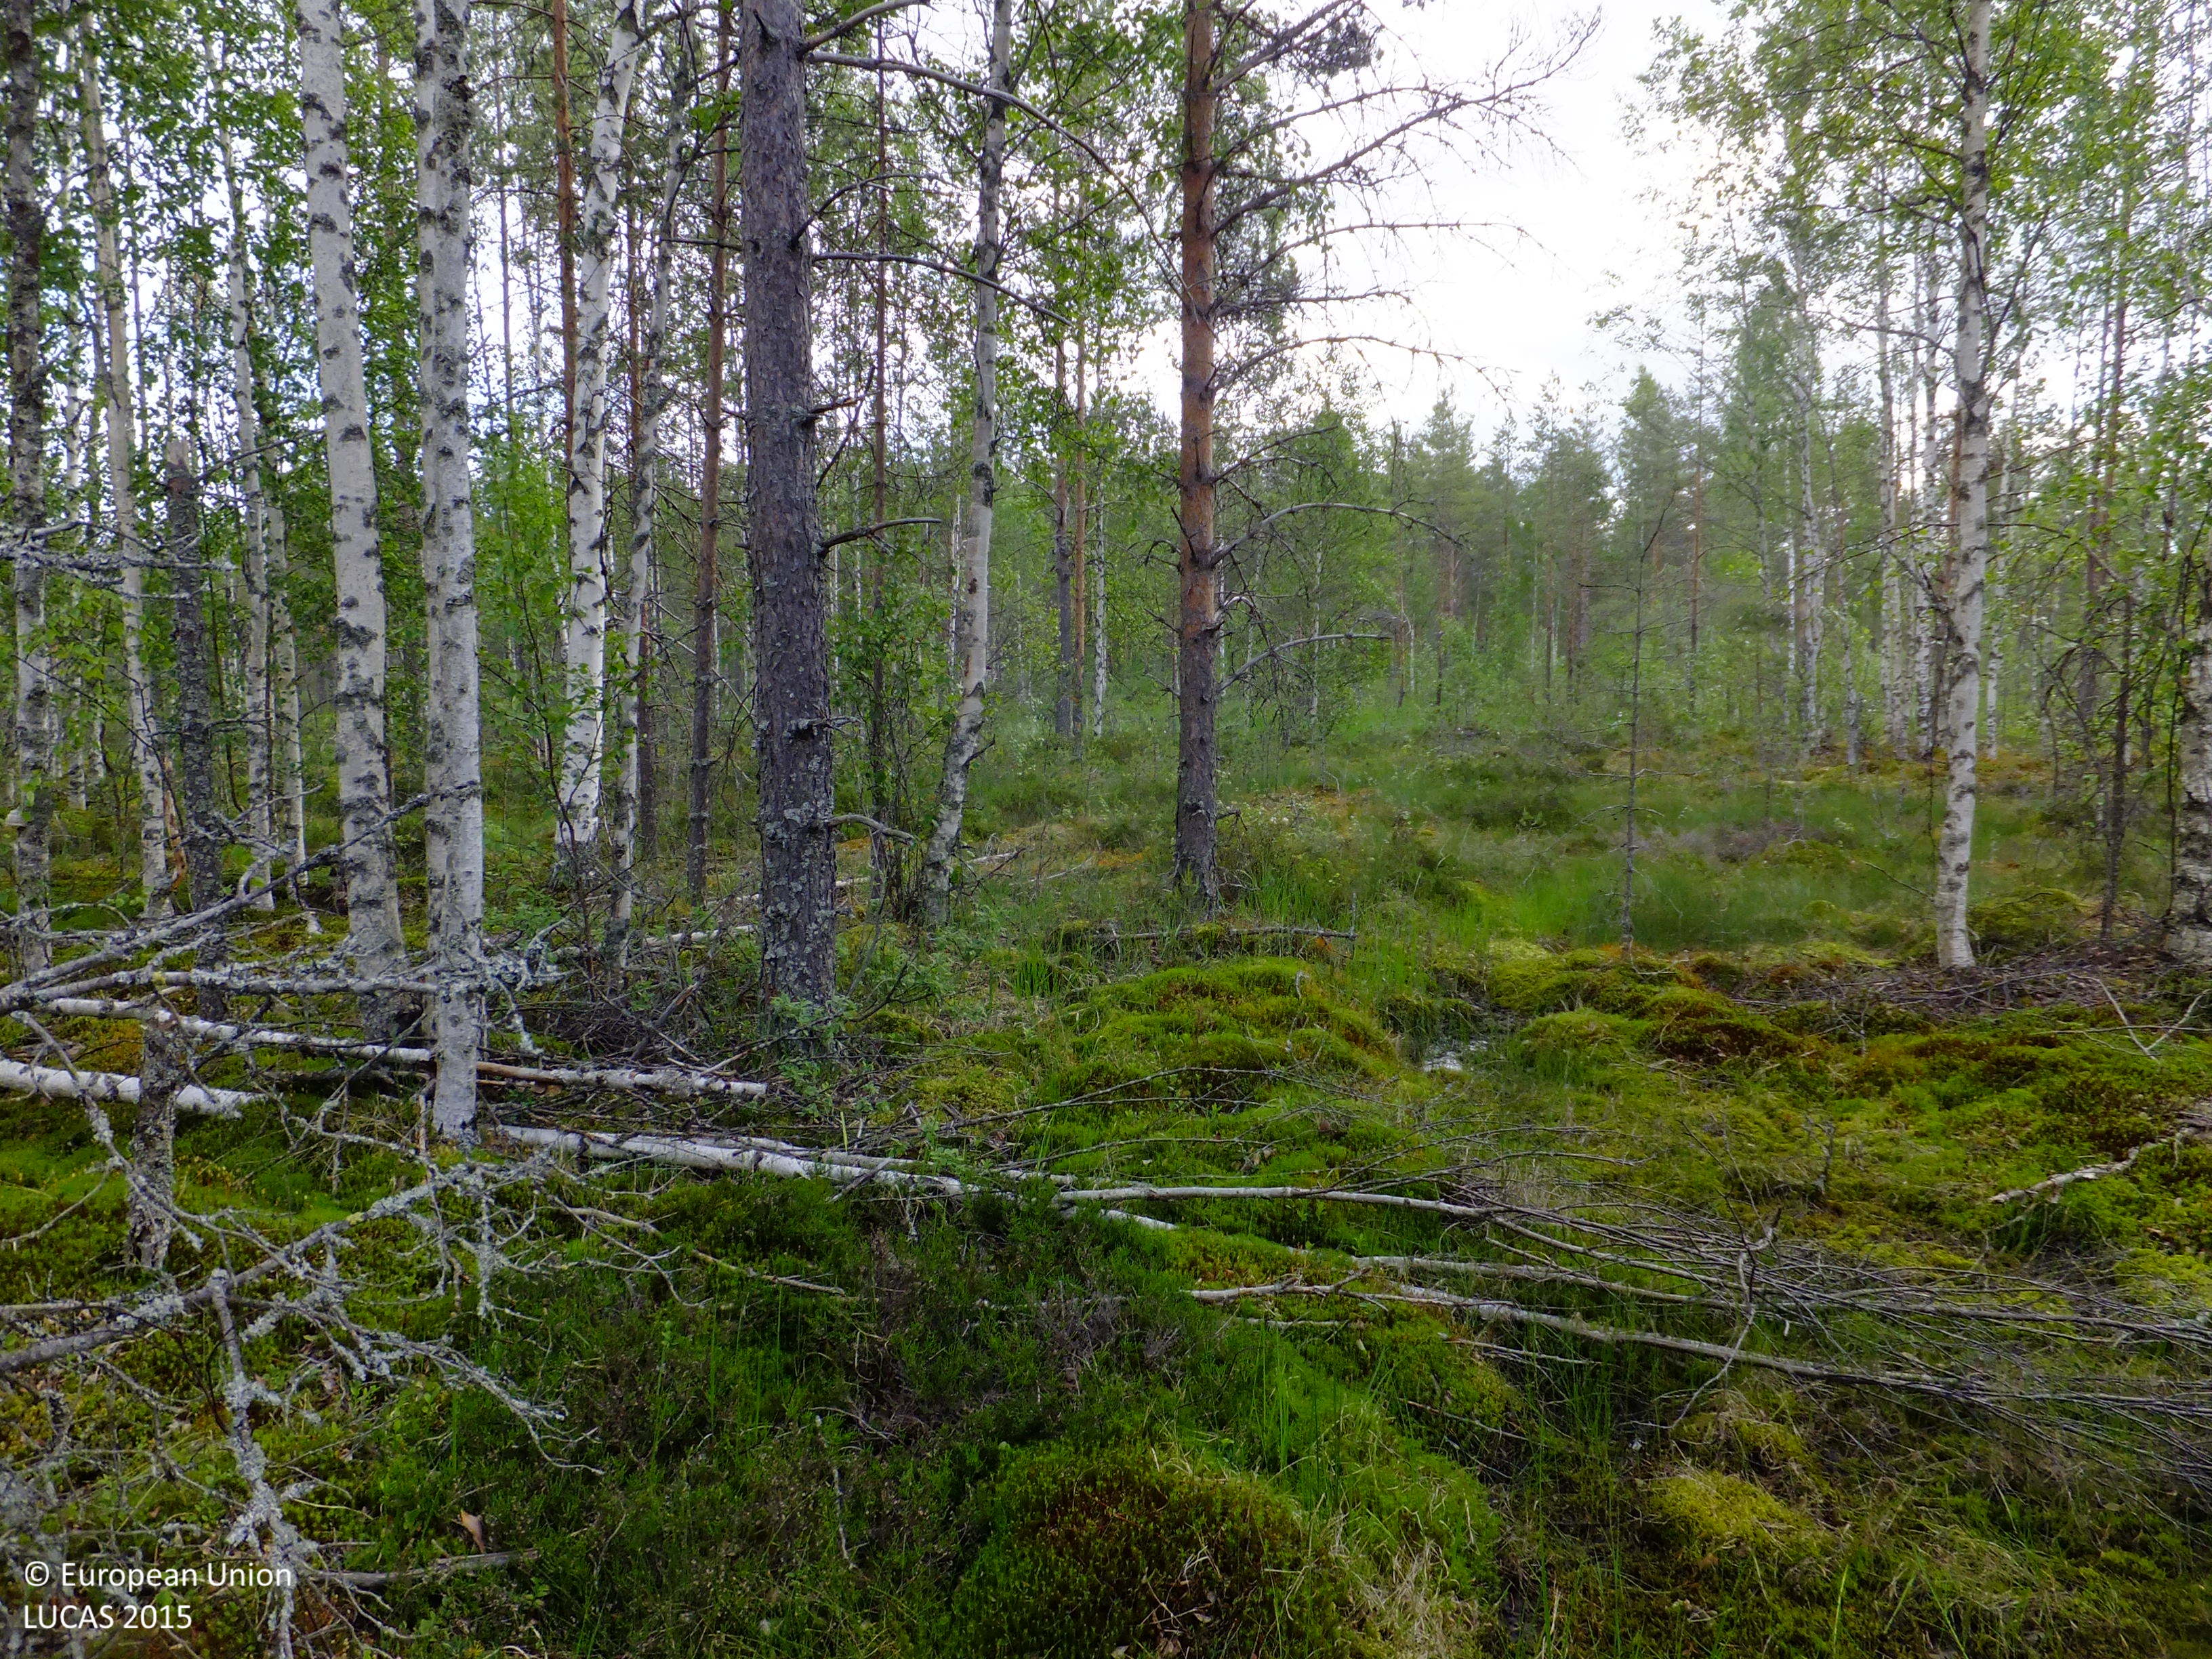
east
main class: Woodland
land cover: Pine dominated mixed woodland
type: boreal forest
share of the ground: 25 - 50 %
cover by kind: lichens and mosses 35 %, shrubs 20 %, herbaceous plants 20 %, broadleaved forest trees 15 %, coniferous forest trees 10 %
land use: Forestry
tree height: > 5 m
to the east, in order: Pine dominated mixed woodland; Ditches and canals; Pine dominated mixed woodland; Ditches and canals; Pine dominated mixed woodland; Ditches and canals; Pine dominated mixed woodland; Ditches and canals; Pine dominated mixed woodland
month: July
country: FI
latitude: 63.3706
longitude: 24.3770
